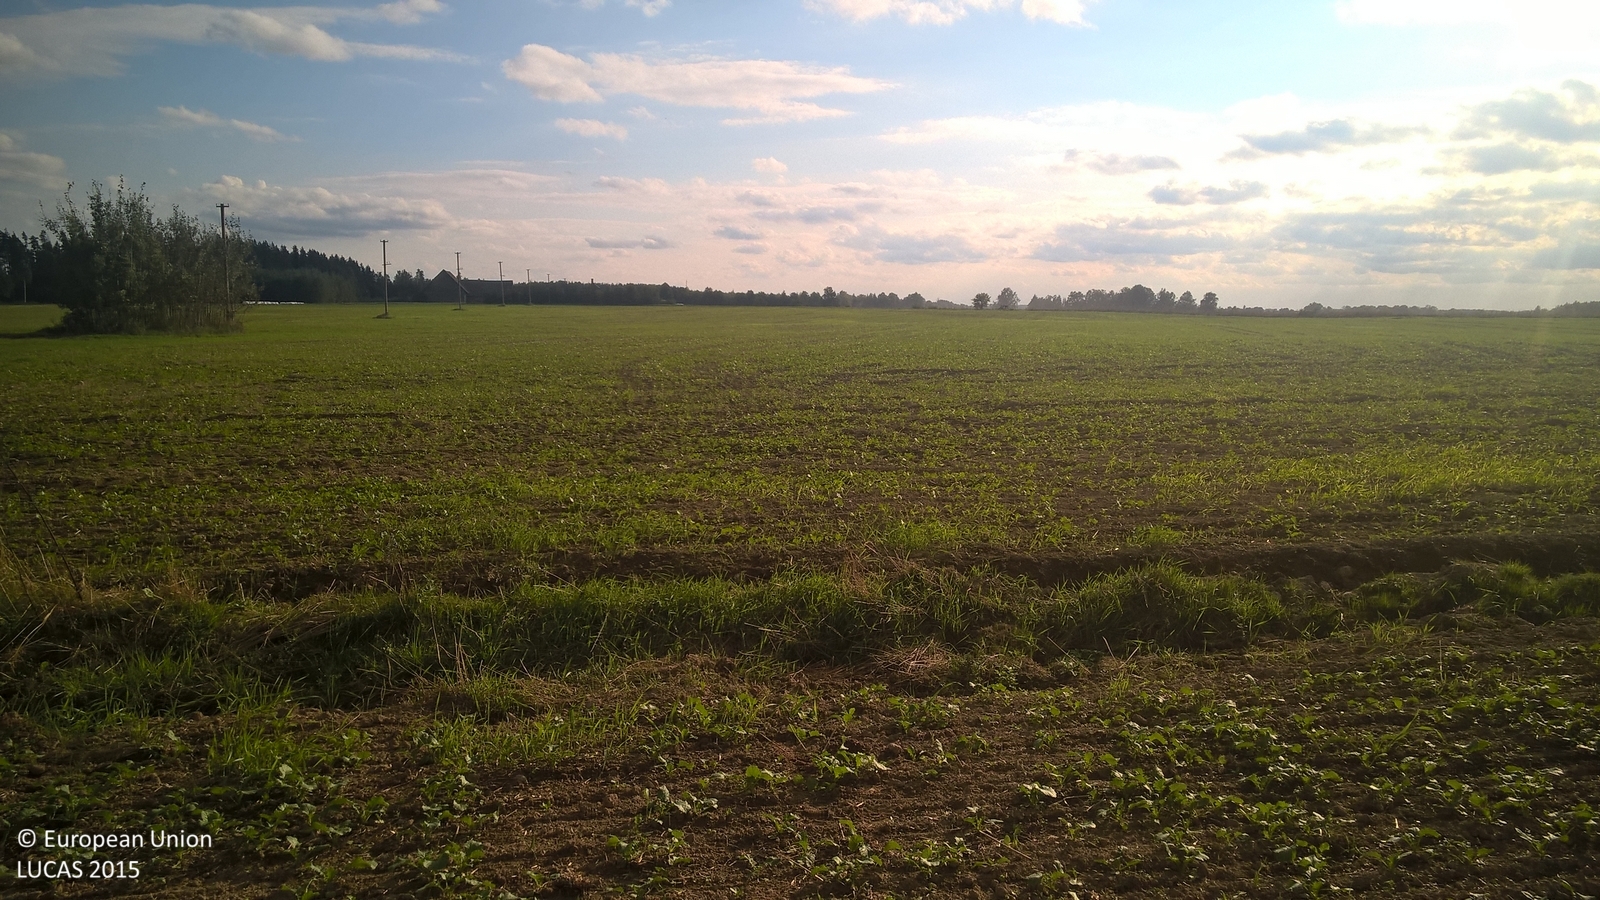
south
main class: Cropland
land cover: Rape and turnip rape
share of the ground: 25 - 50 %
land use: Agriculture (excluding fallow land and kitchen gardens)
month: September
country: LV
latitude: 57.4472
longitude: 25.5980
